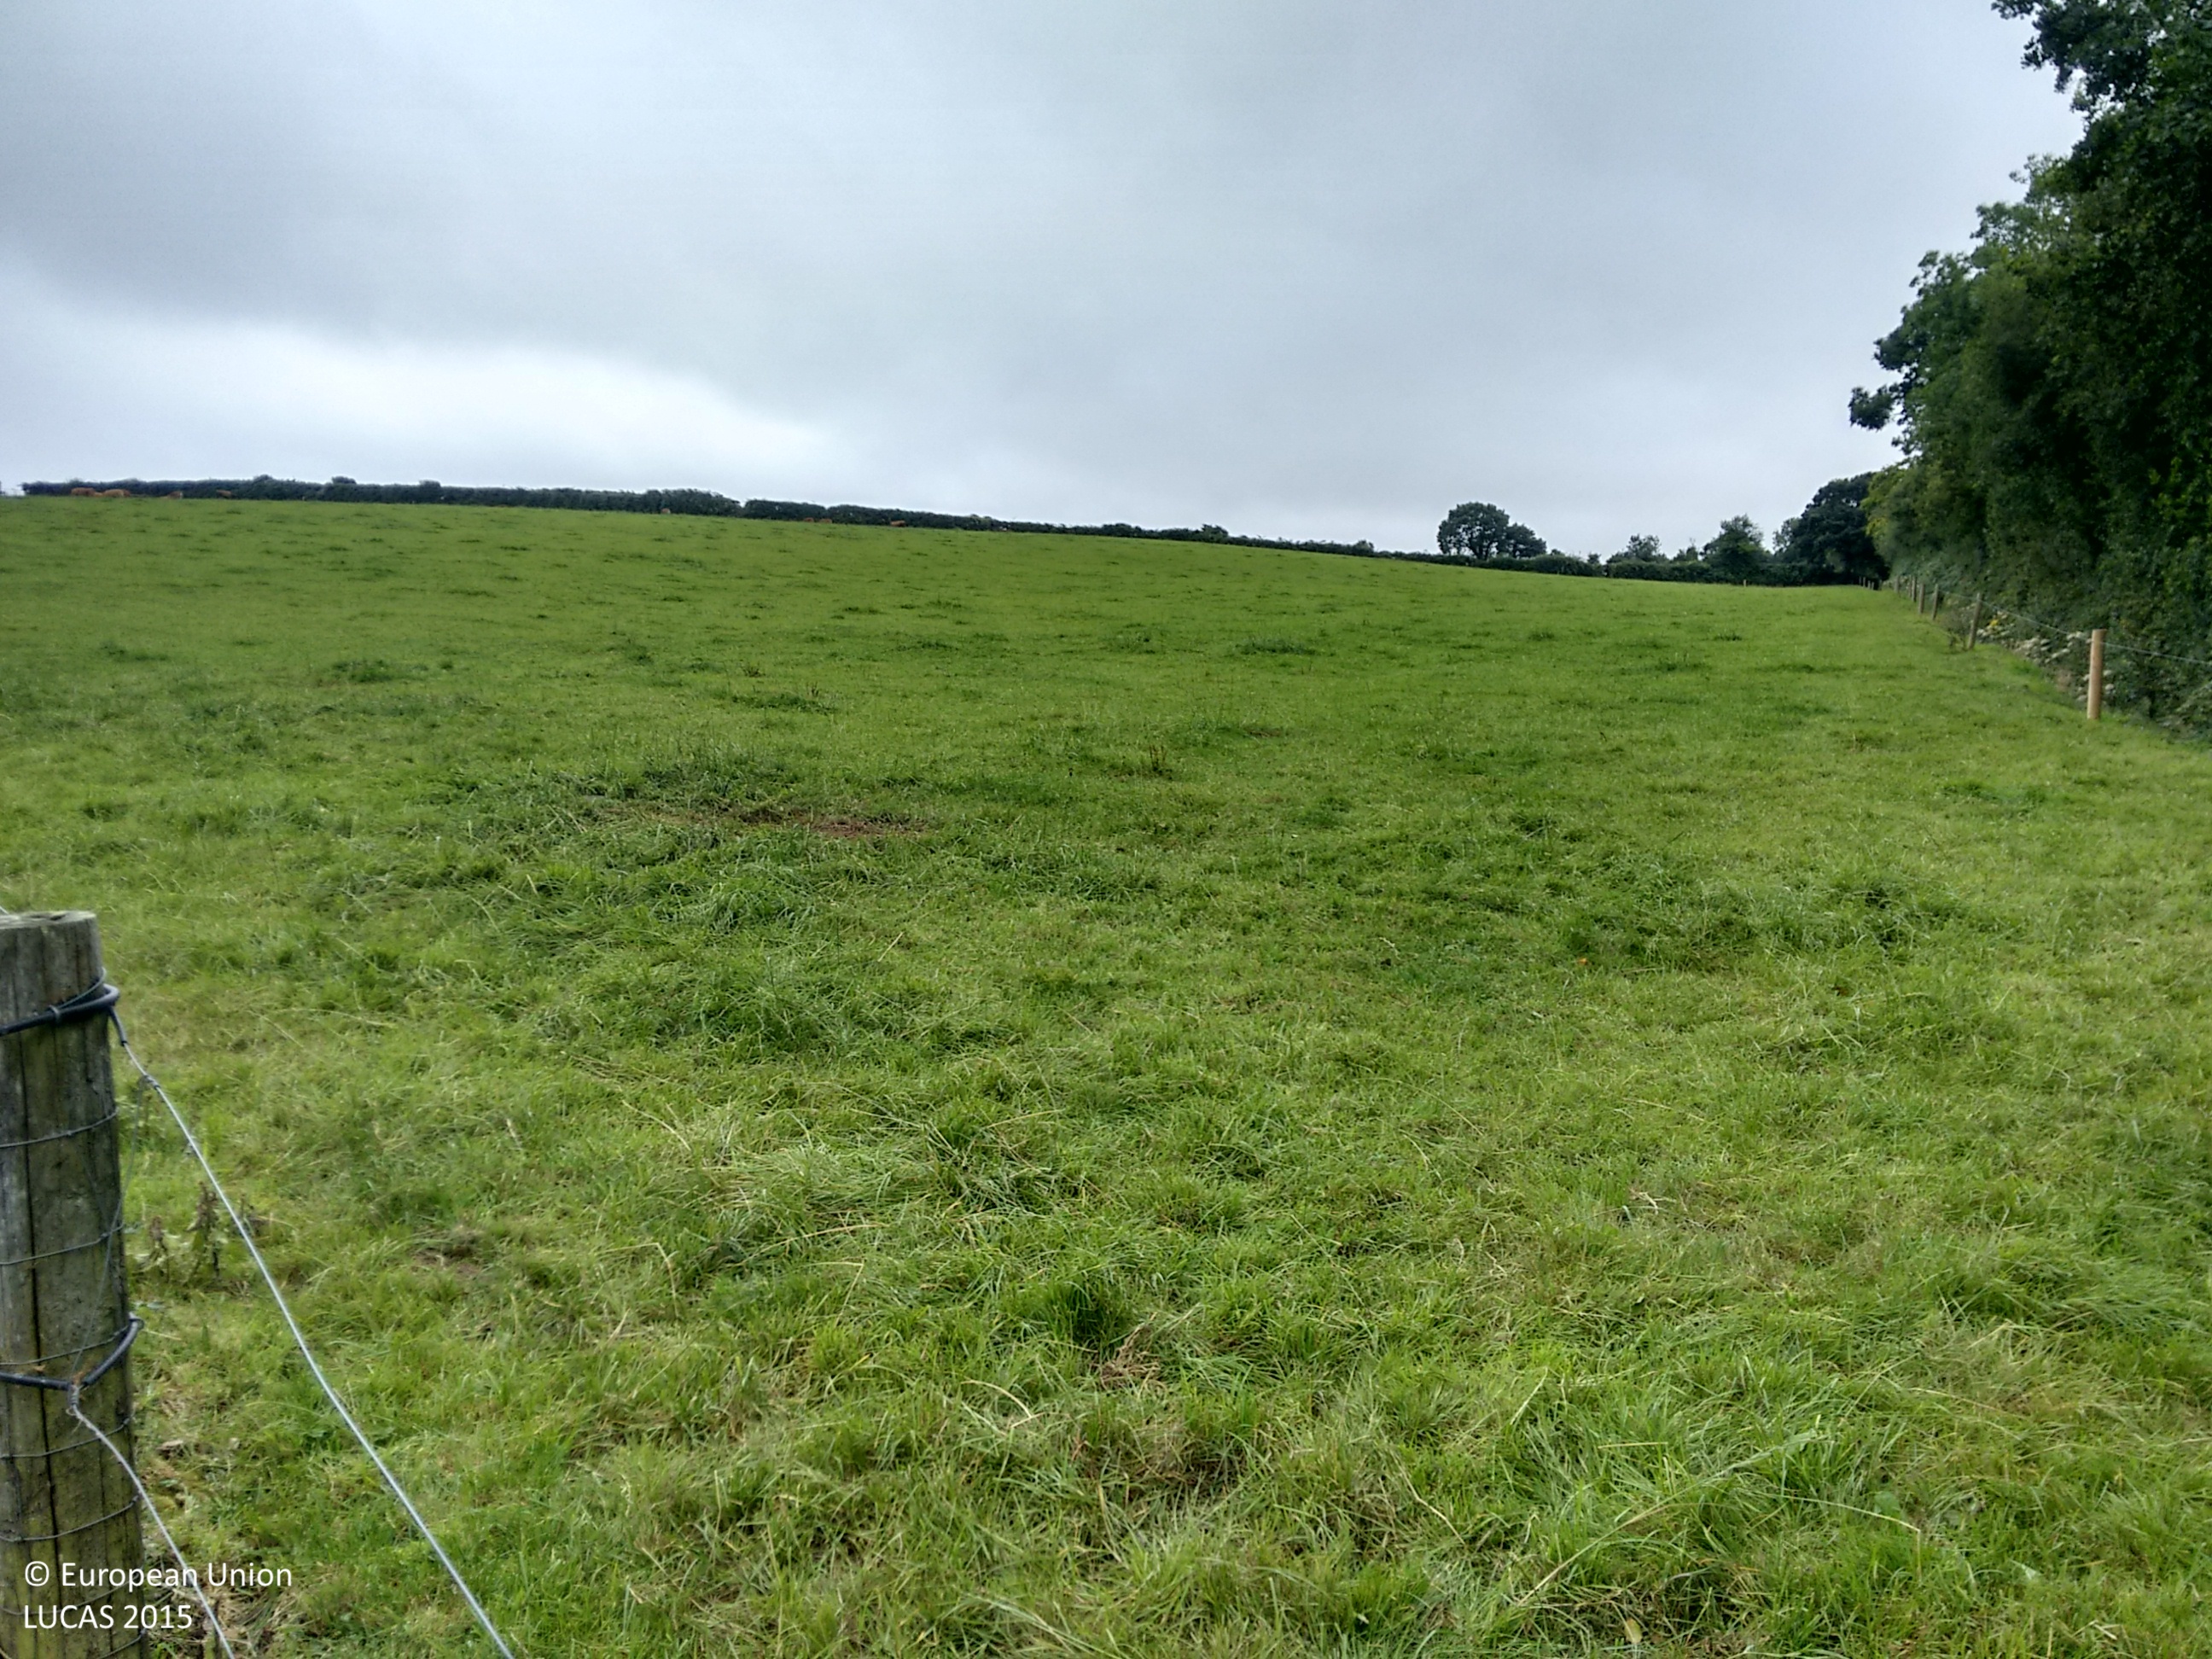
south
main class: Grassland
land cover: Grassland without tree/shrub cover
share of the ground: > 75 %
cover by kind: herbaceous plants 100 %
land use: Agriculture (excluding fallow land and kitchen gardens)
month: August
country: IE
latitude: 52.4472
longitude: -6.5946
